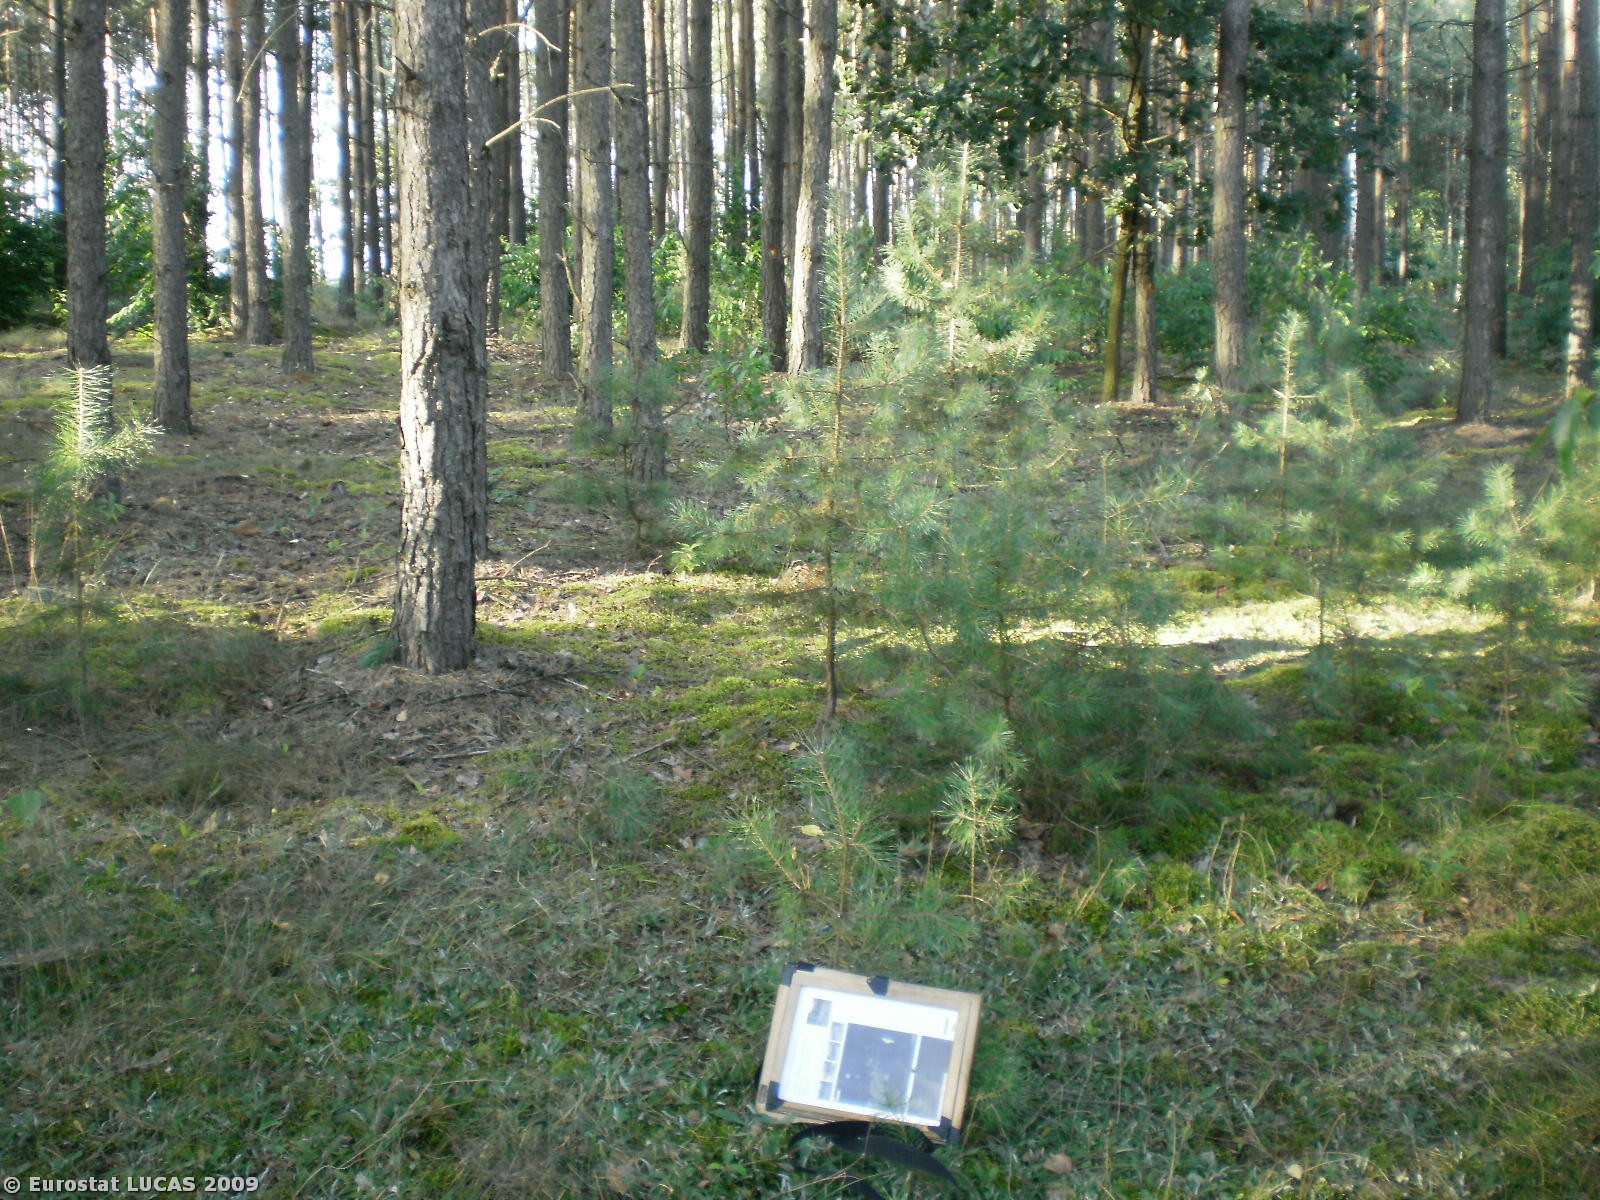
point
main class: Woodland
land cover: Coniferous woodland
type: hemiboreal forest and nemoral coniferous forest and mixed broadleaved-coniferous forest
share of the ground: > 75 %
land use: Forestry
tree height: > 5 m
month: August
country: PL
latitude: 53.1228
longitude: 20.9364
